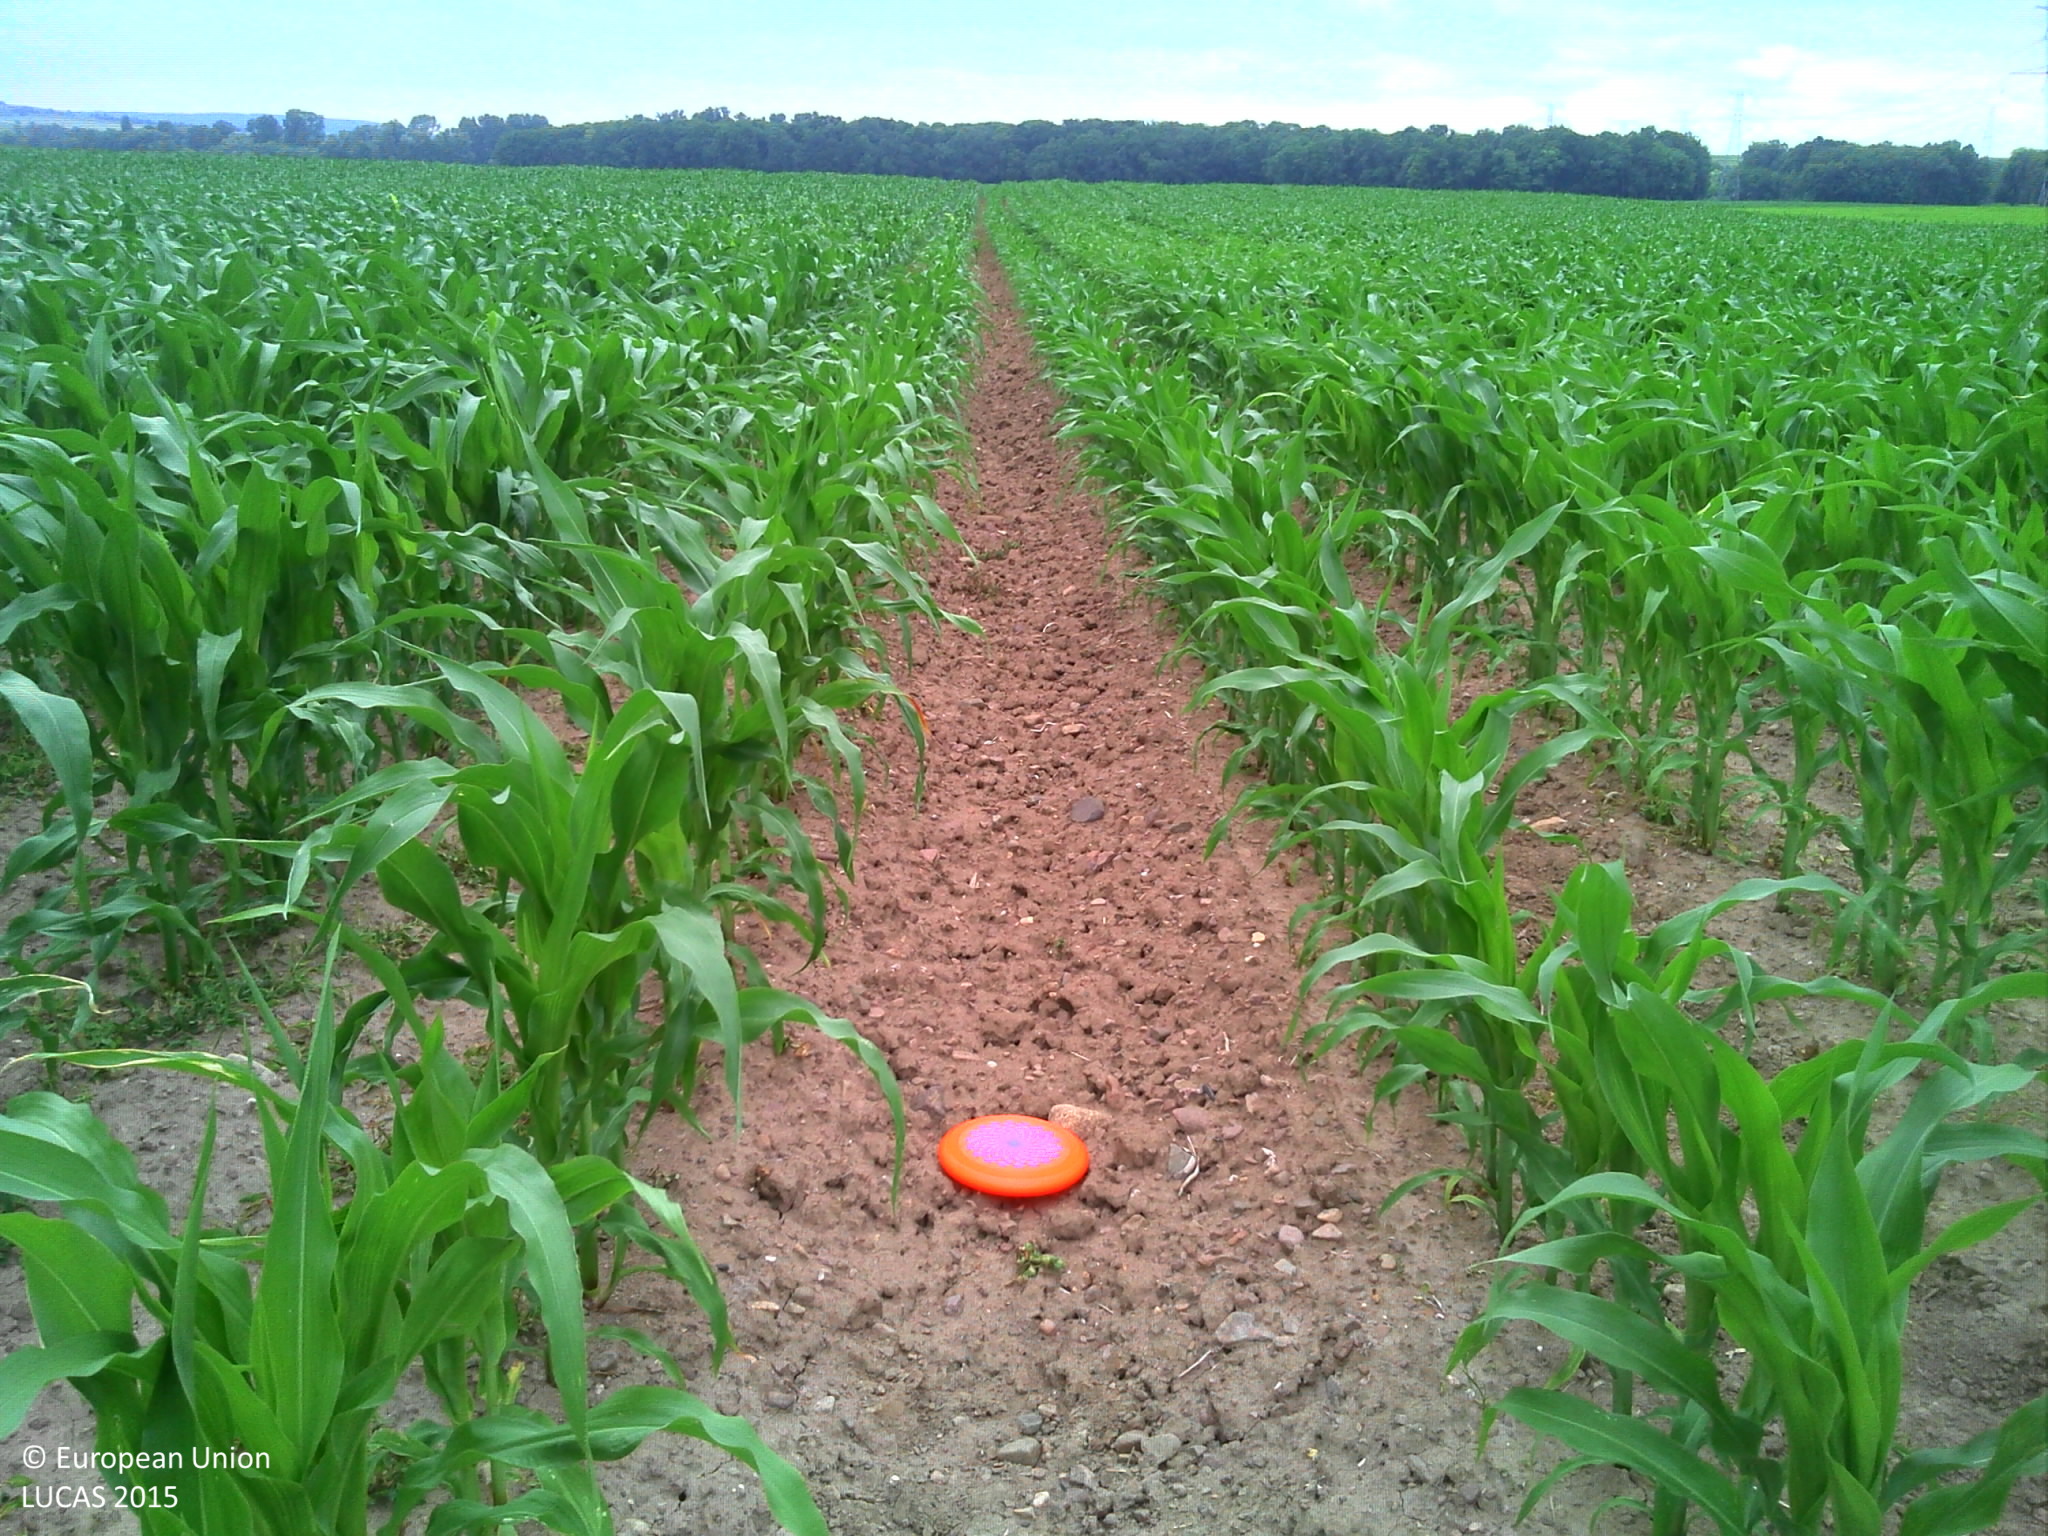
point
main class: Cropland
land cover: Maize
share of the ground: 25 - 50 %
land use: Agriculture (excluding fallow land and kitchen gardens)
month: June
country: FR
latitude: 48.5563
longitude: 7.5485
